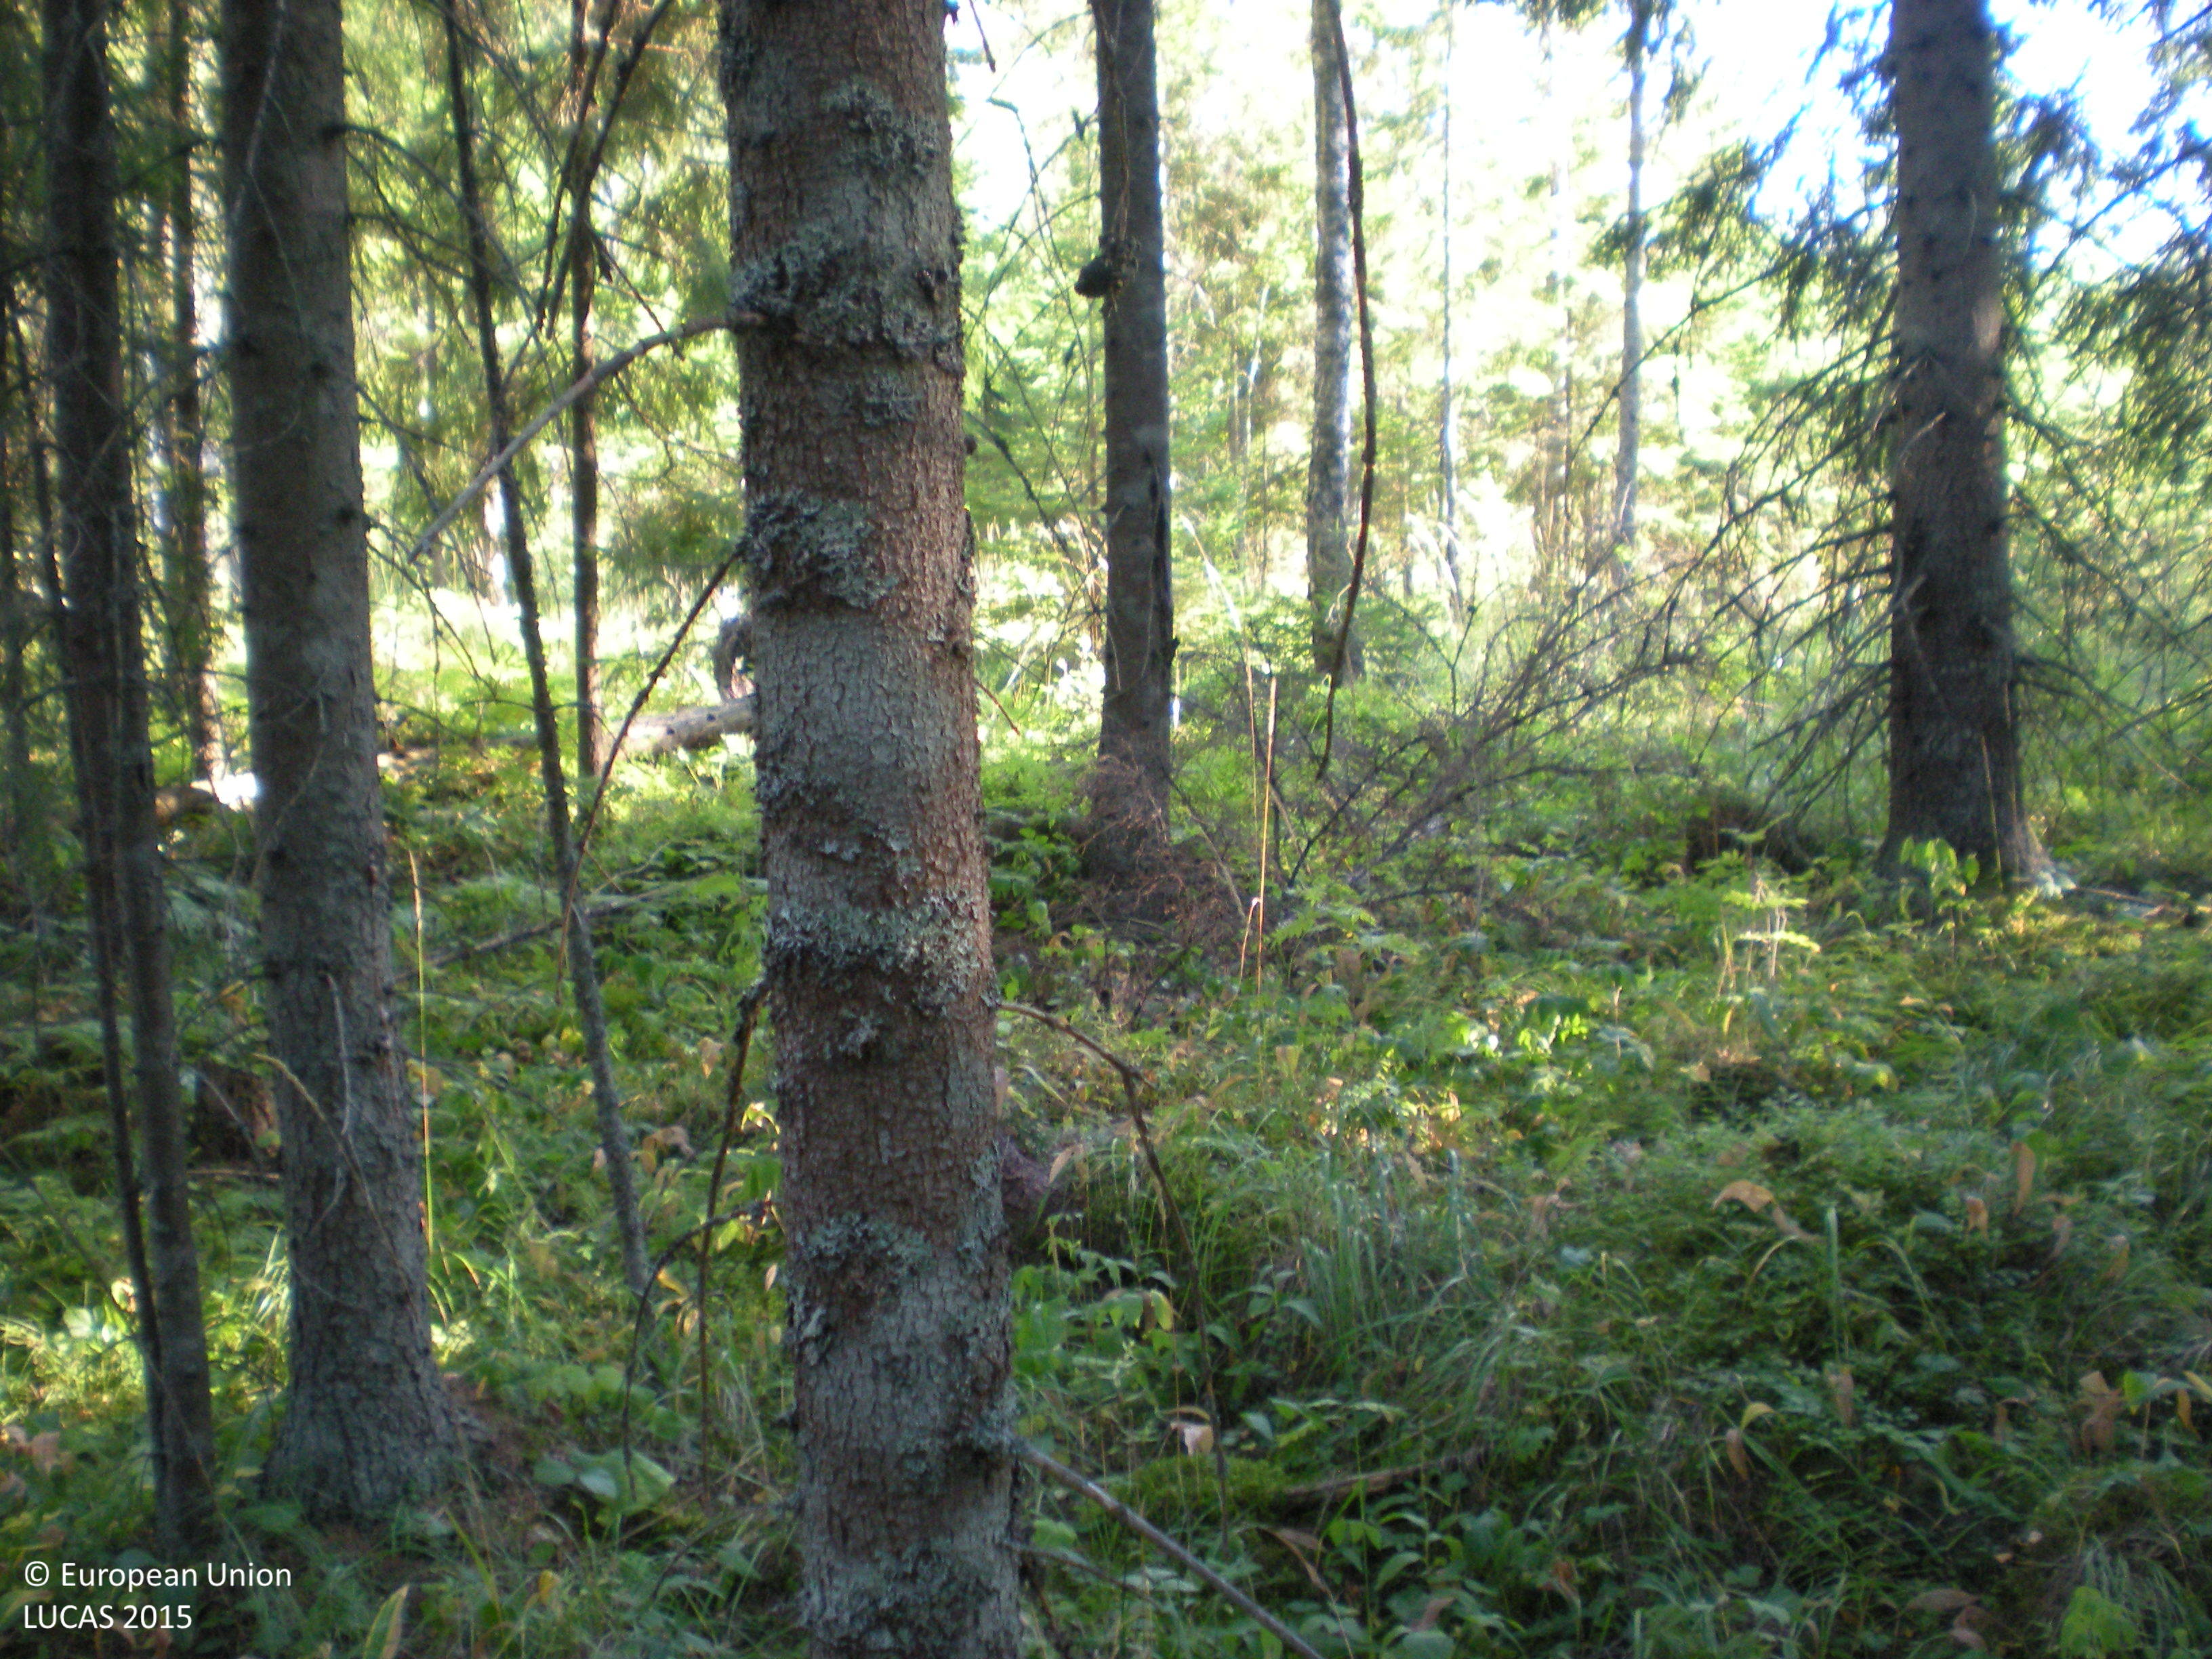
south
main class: Woodland
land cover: Spruce dominated coniferous woodland
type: boreal forest
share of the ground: 50 - 75 %
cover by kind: coniferous forest trees 70 %, herbaceous plants 10 %, lichens and mosses 10 %, broadleaved forest trees 5 %, shrubs 5 %
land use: Forestry
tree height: > 5 m
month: August
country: SE
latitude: 60.5701
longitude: 17.3062
